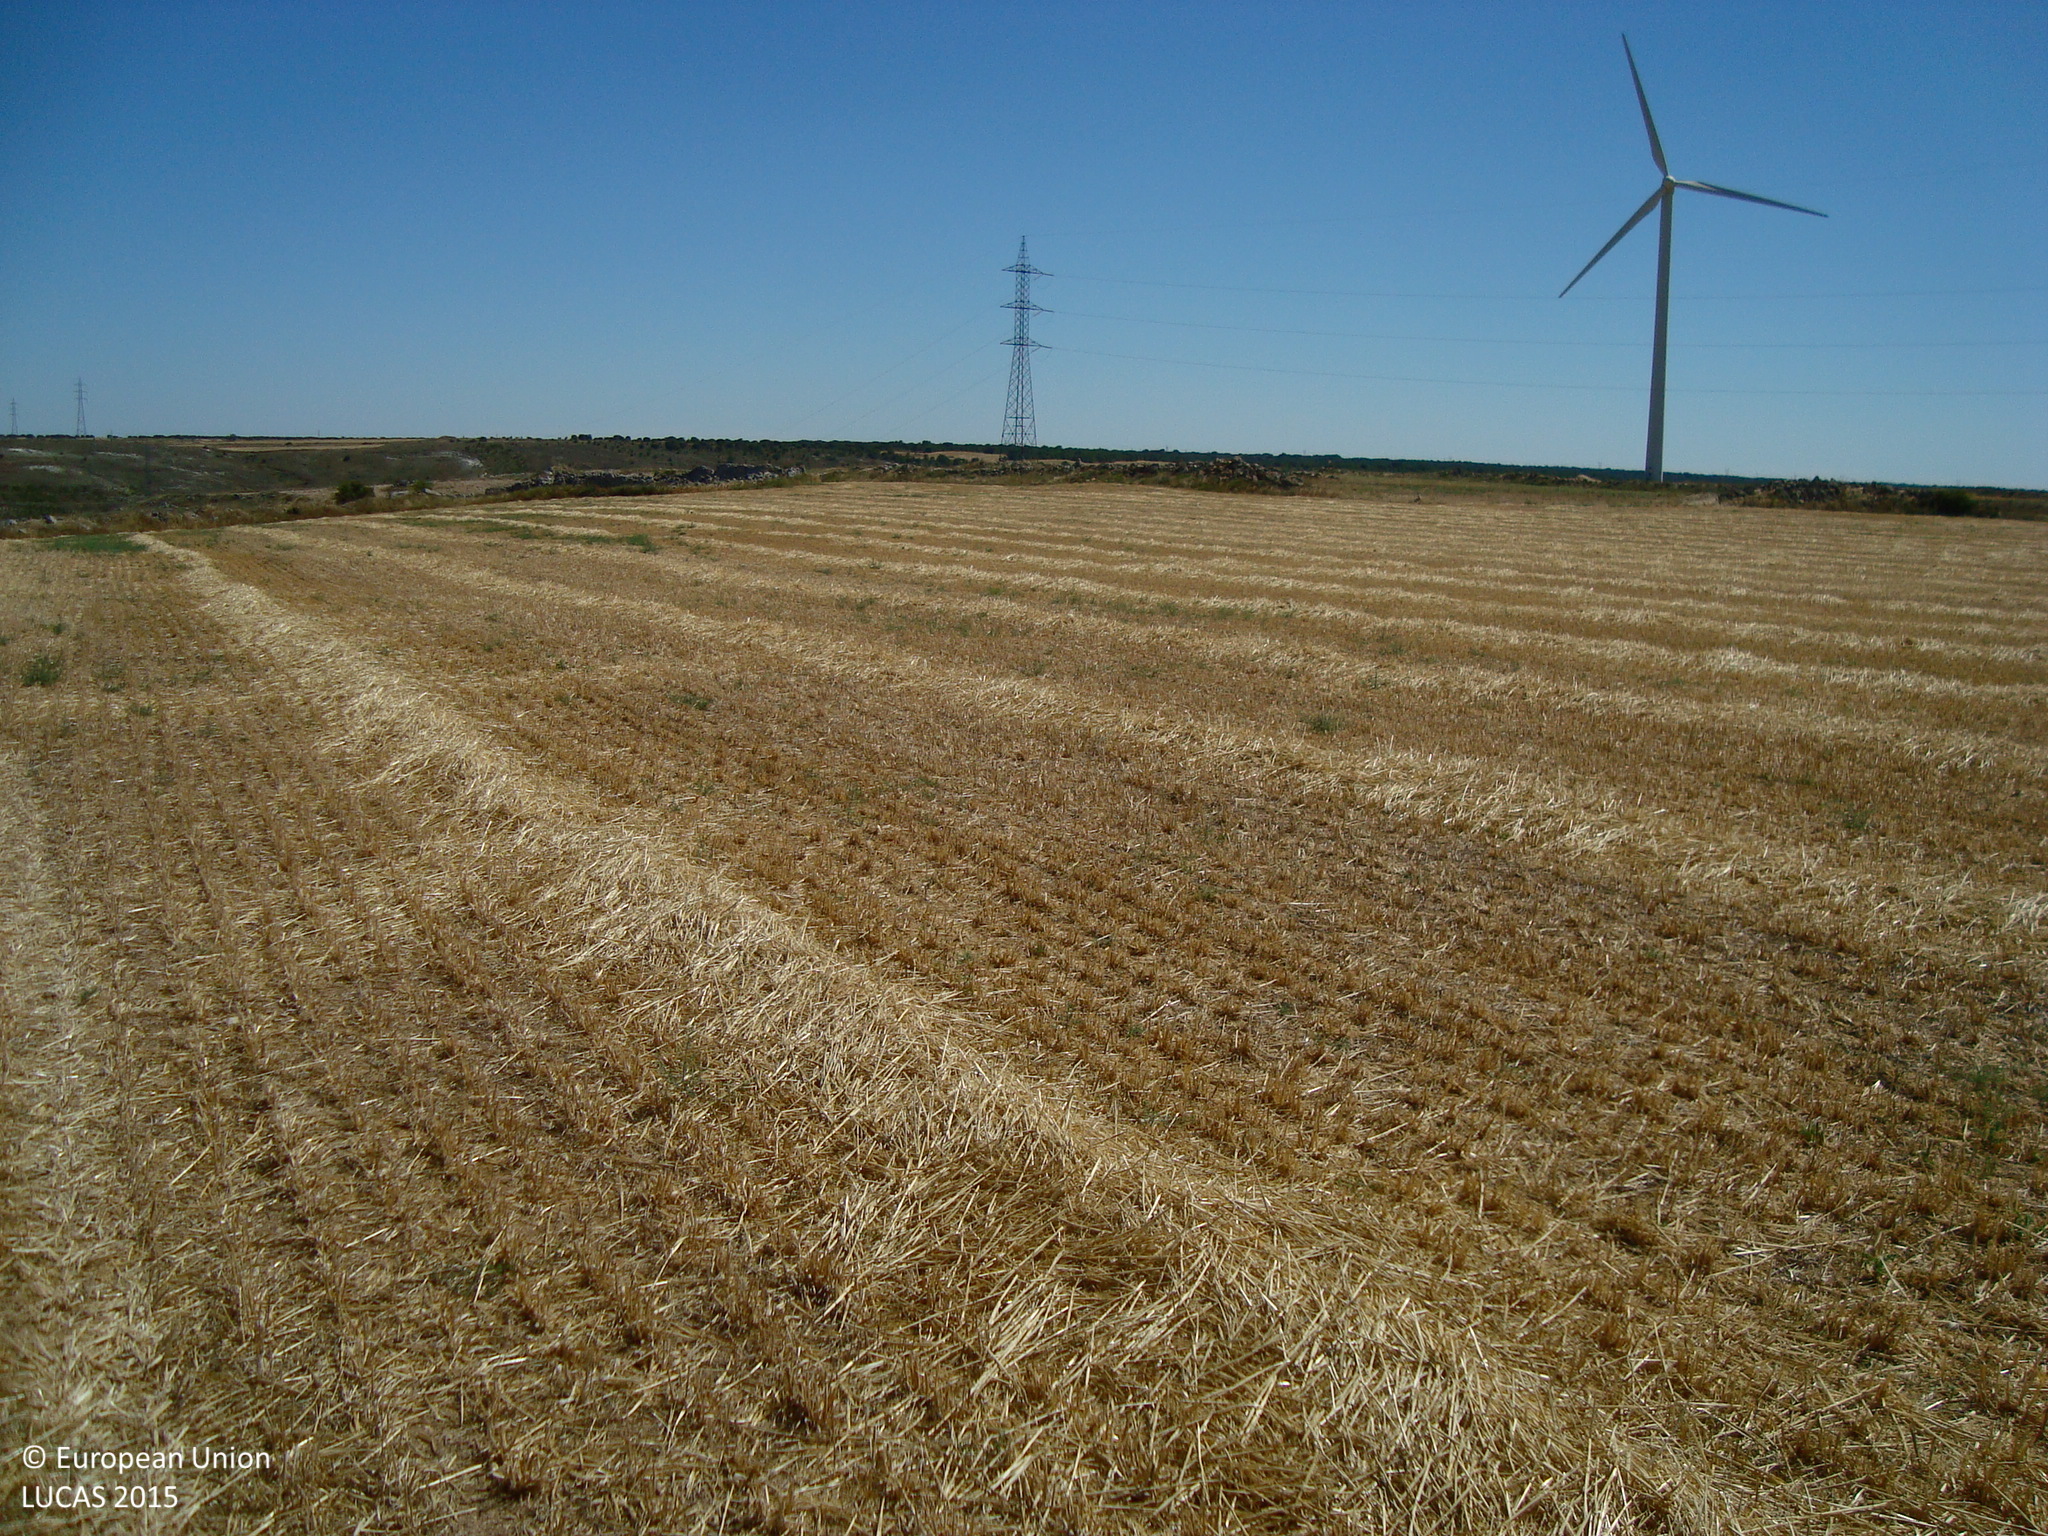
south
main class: Cropland
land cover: Barley
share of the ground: > 75 %
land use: Agriculture (excluding fallow land and kitchen gardens)
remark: Harvested field
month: August
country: ES
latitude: 42.1971
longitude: -4.1994
